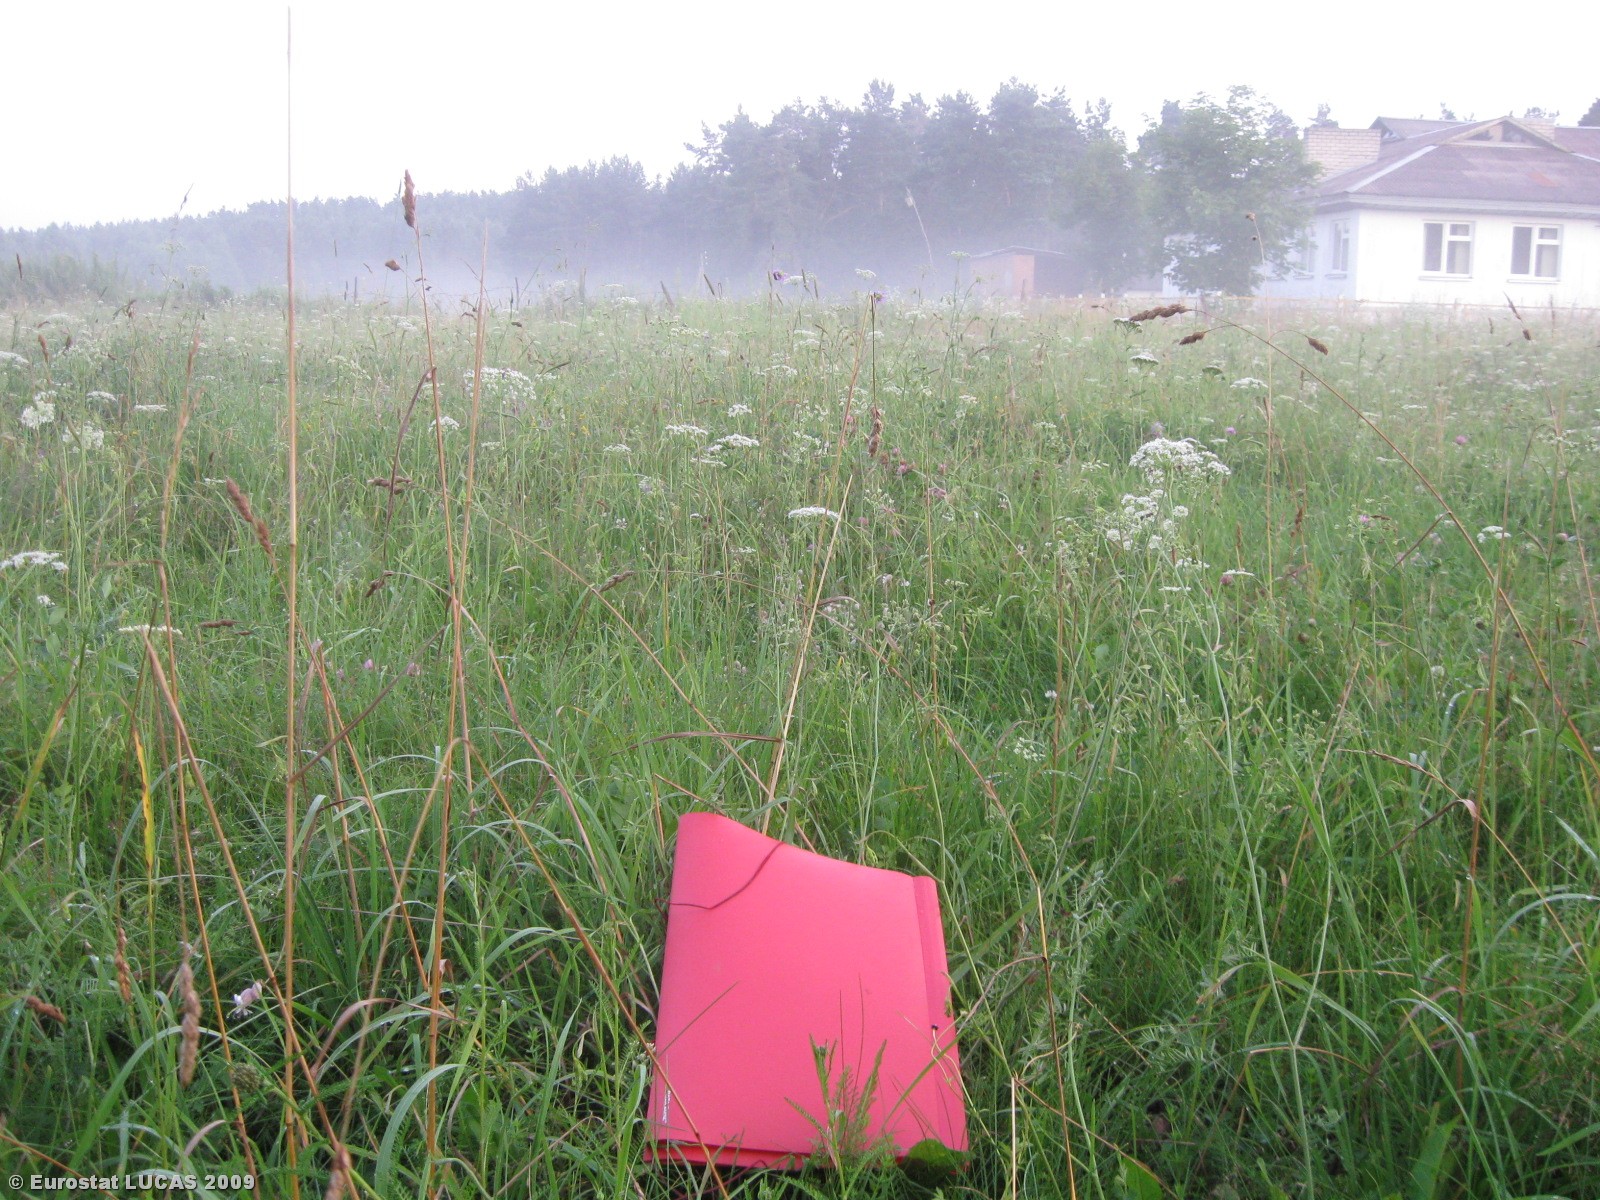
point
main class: Grassland
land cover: Grassland without tree/shrub cover
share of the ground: > 75 %
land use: Agriculture (excluding fallow land and kitchen gardens)
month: July
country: LT
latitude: 54.2872
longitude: 25.0322
